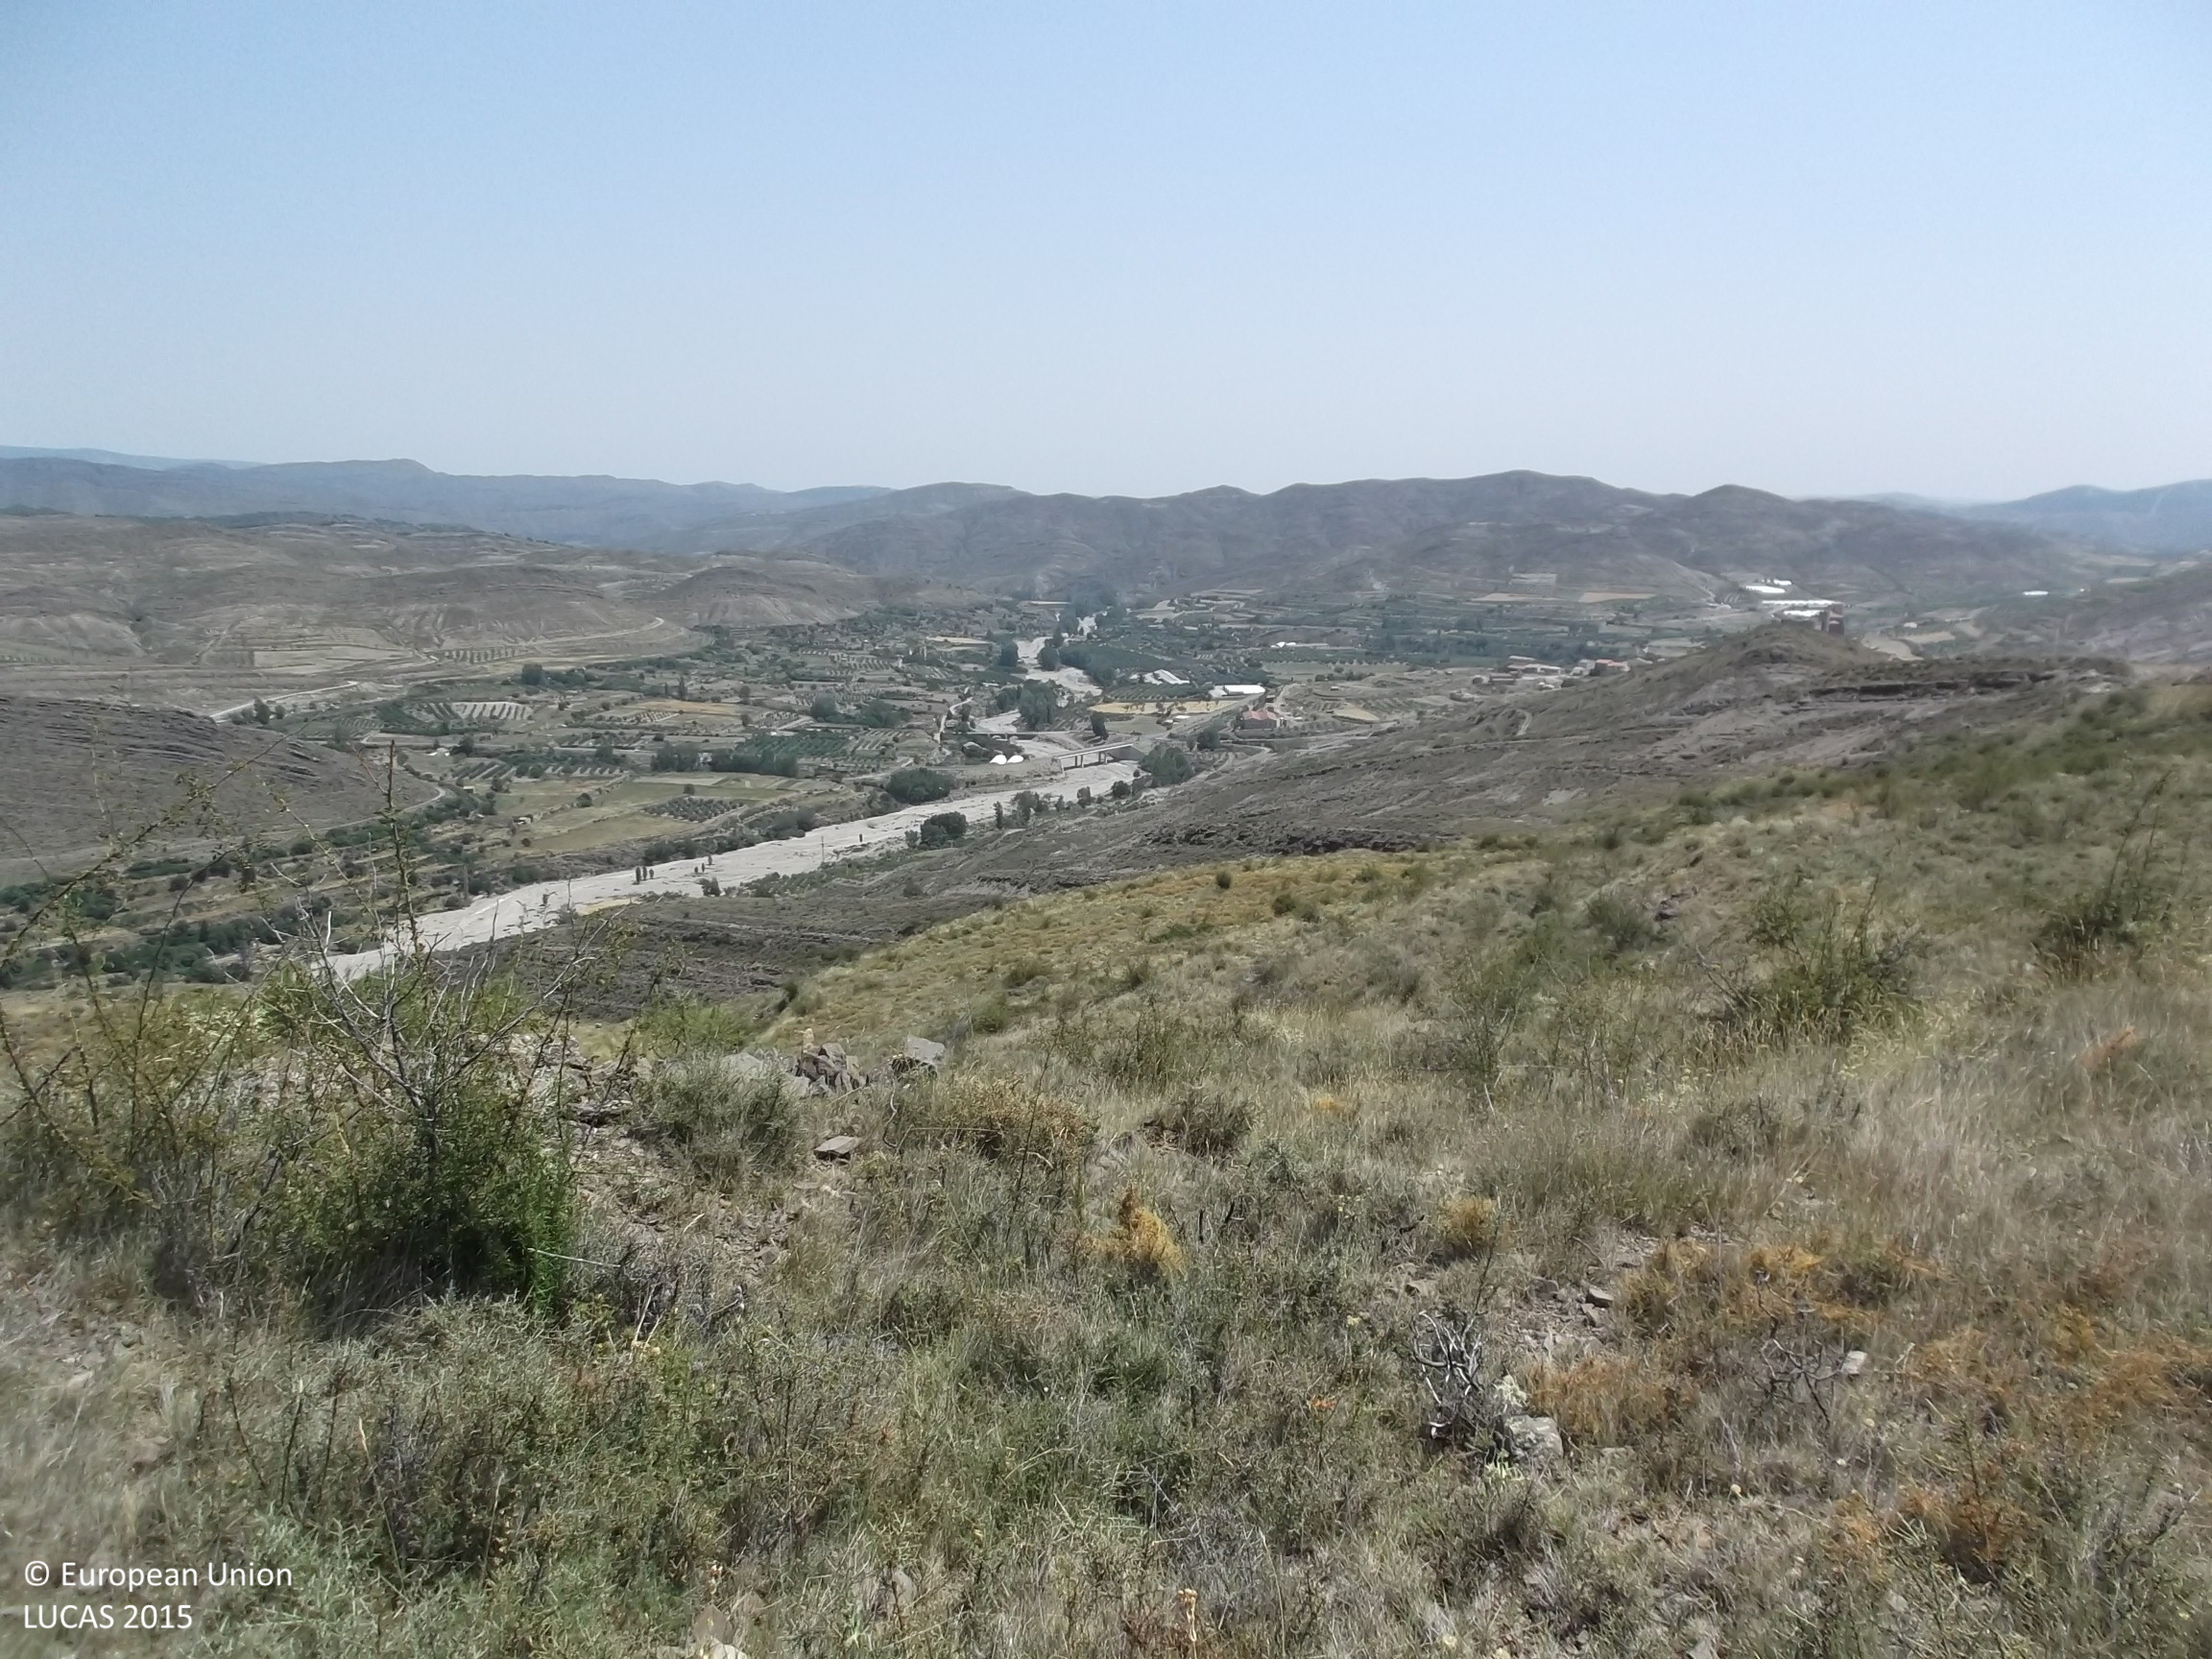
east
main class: Shrubland
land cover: Shrubland without tree cover
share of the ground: 50 - 75 %
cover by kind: shrubs 60 %, herbaceous plants 30 %, unconsolidated bare surface 10 %
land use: Agriculture (excluding fallow land and kitchen gardens)
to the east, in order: Shrubland without tree cover; Dry stone walls; Grassland without tree/shrub cover; Dry stone walls; Abandoned hedges; Grassland without tree/shrub cover; Dry stone walls; Abandoned hedges; Grassland without tree/shrub cover; Dry stone walls; Shrubland without tree cover
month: July
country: ES
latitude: 42.0703
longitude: -2.1111
